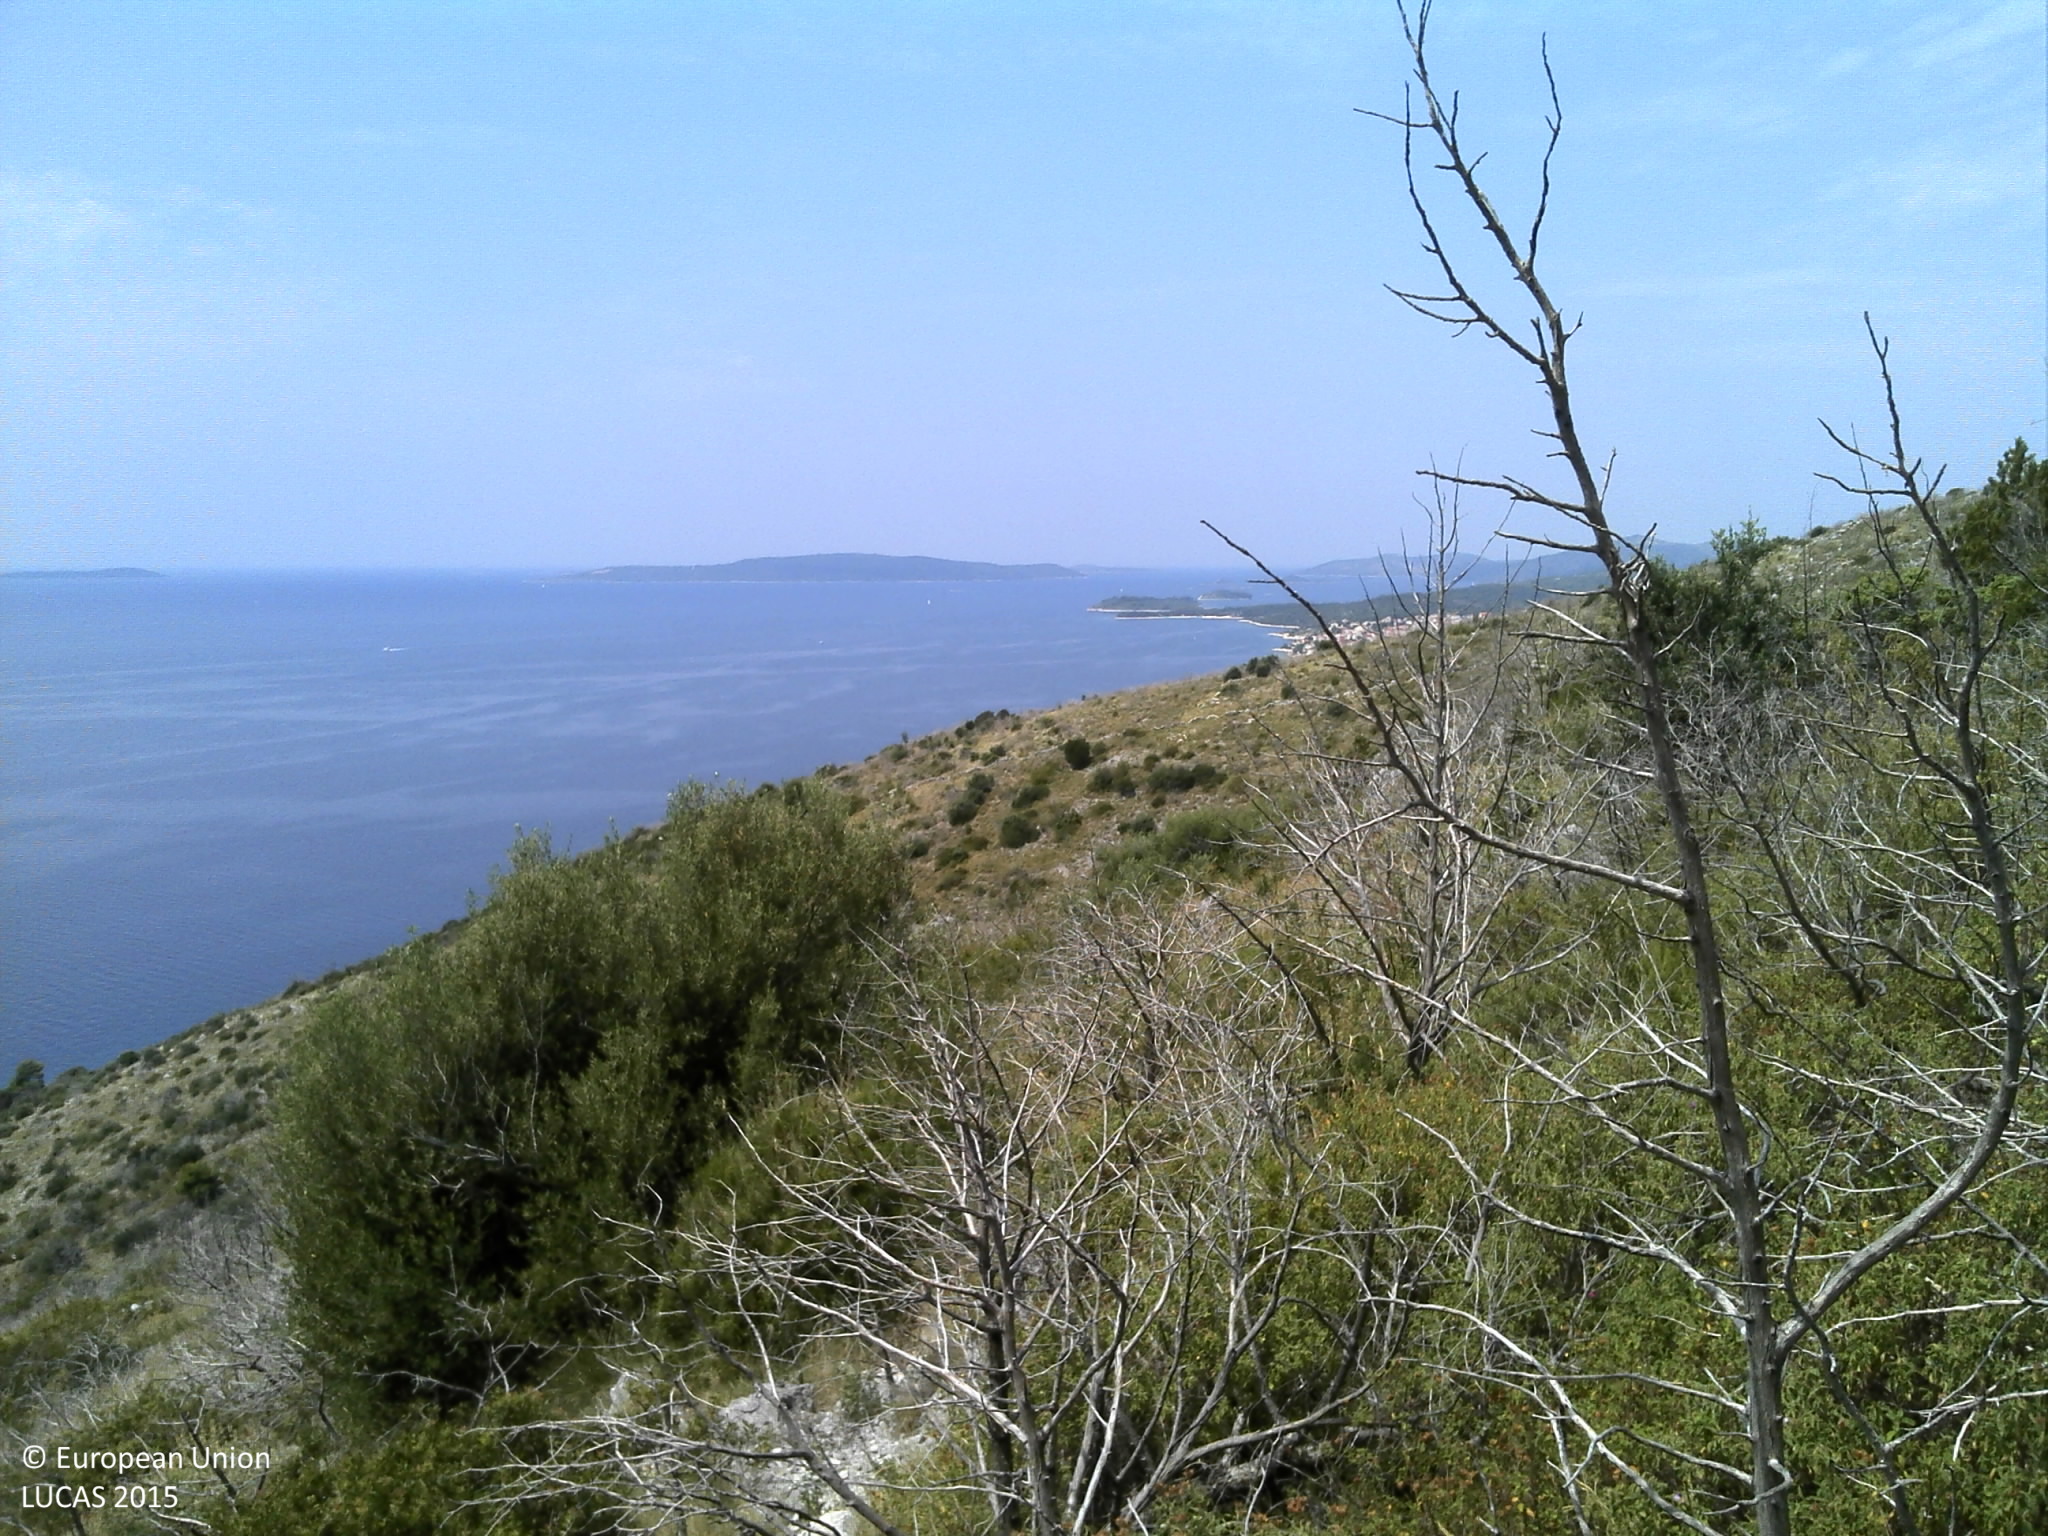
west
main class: Shrubland
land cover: Shrubland with sparse tree cover
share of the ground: 25 - 50 %
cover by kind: shrubs 35 %, herbaceous plants 30 %, consolidated bare surface 20 %, unconsolidated bare surface 10 %, broadleaved forest trees 5 %
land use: Abandoned areas
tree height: < 5 m
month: June
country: HR
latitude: 43.4891
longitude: 16.3092
